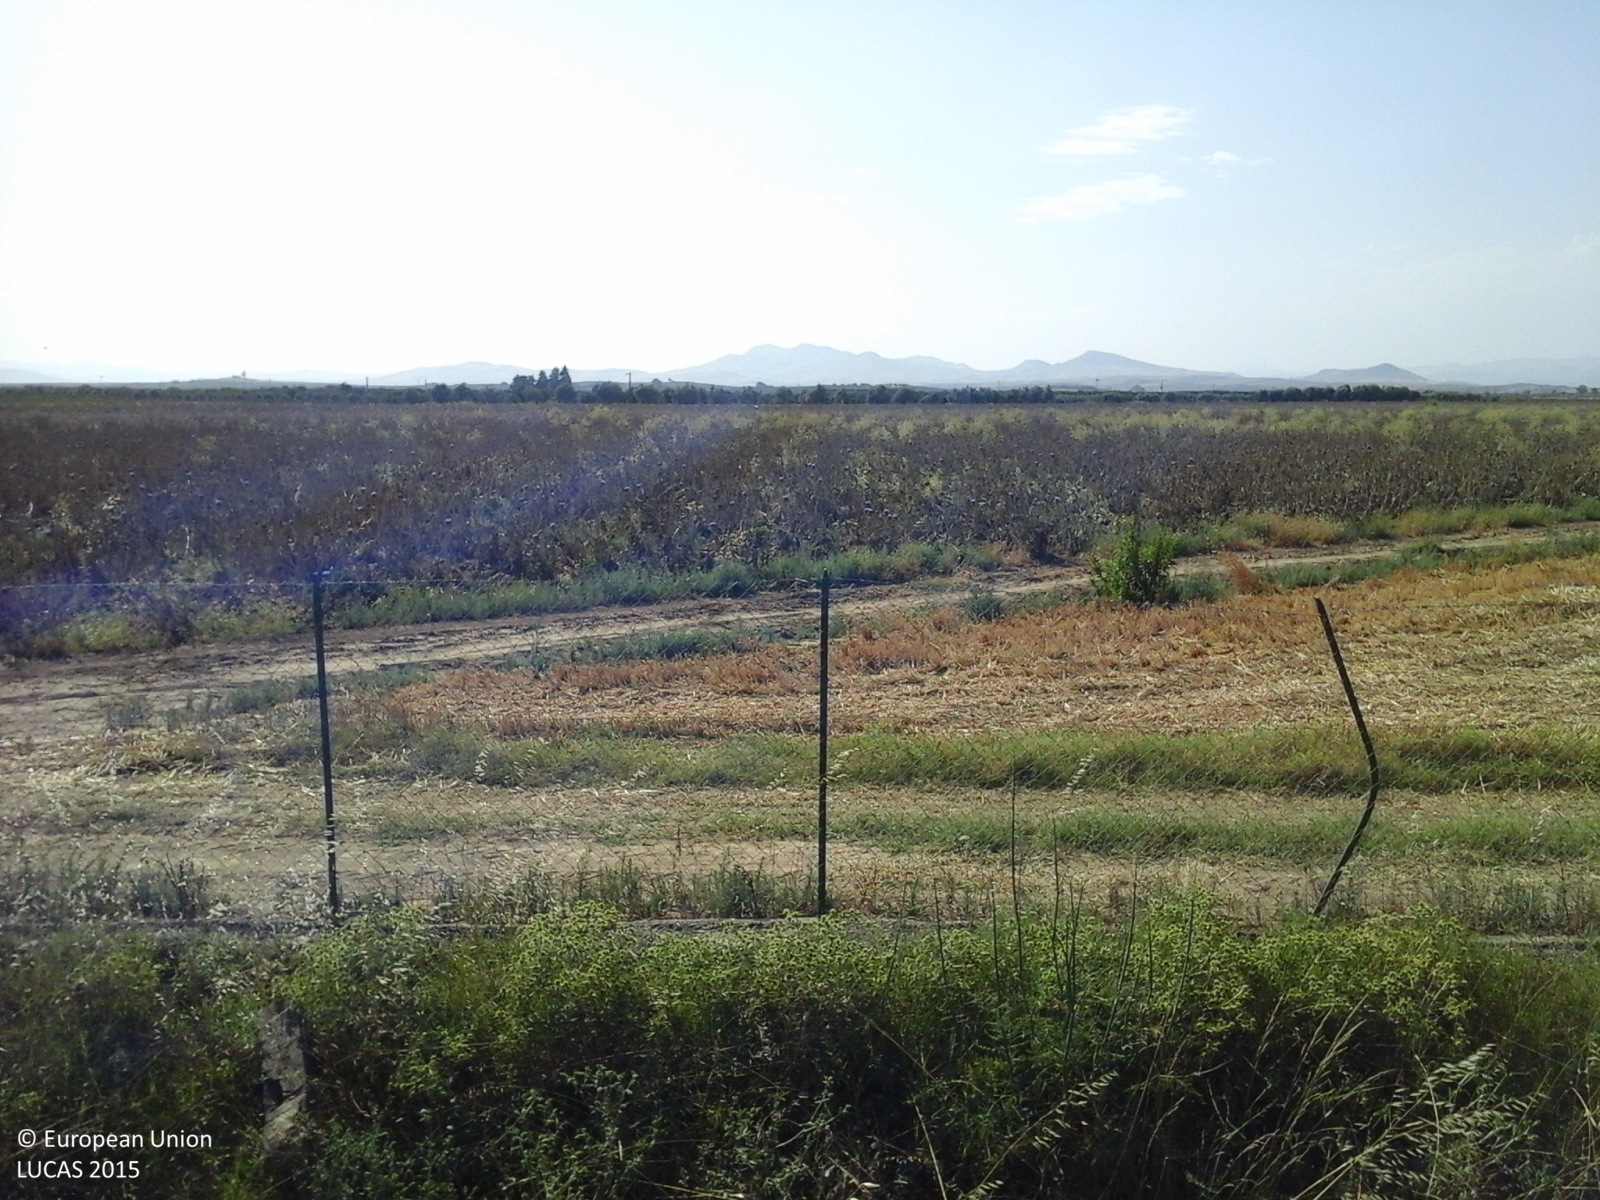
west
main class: Cropland
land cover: Common wheat
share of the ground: > 75 %
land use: Agriculture (excluding fallow land and kitchen gardens)
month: June
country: IT
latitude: 37.4064
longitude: 14.8336
